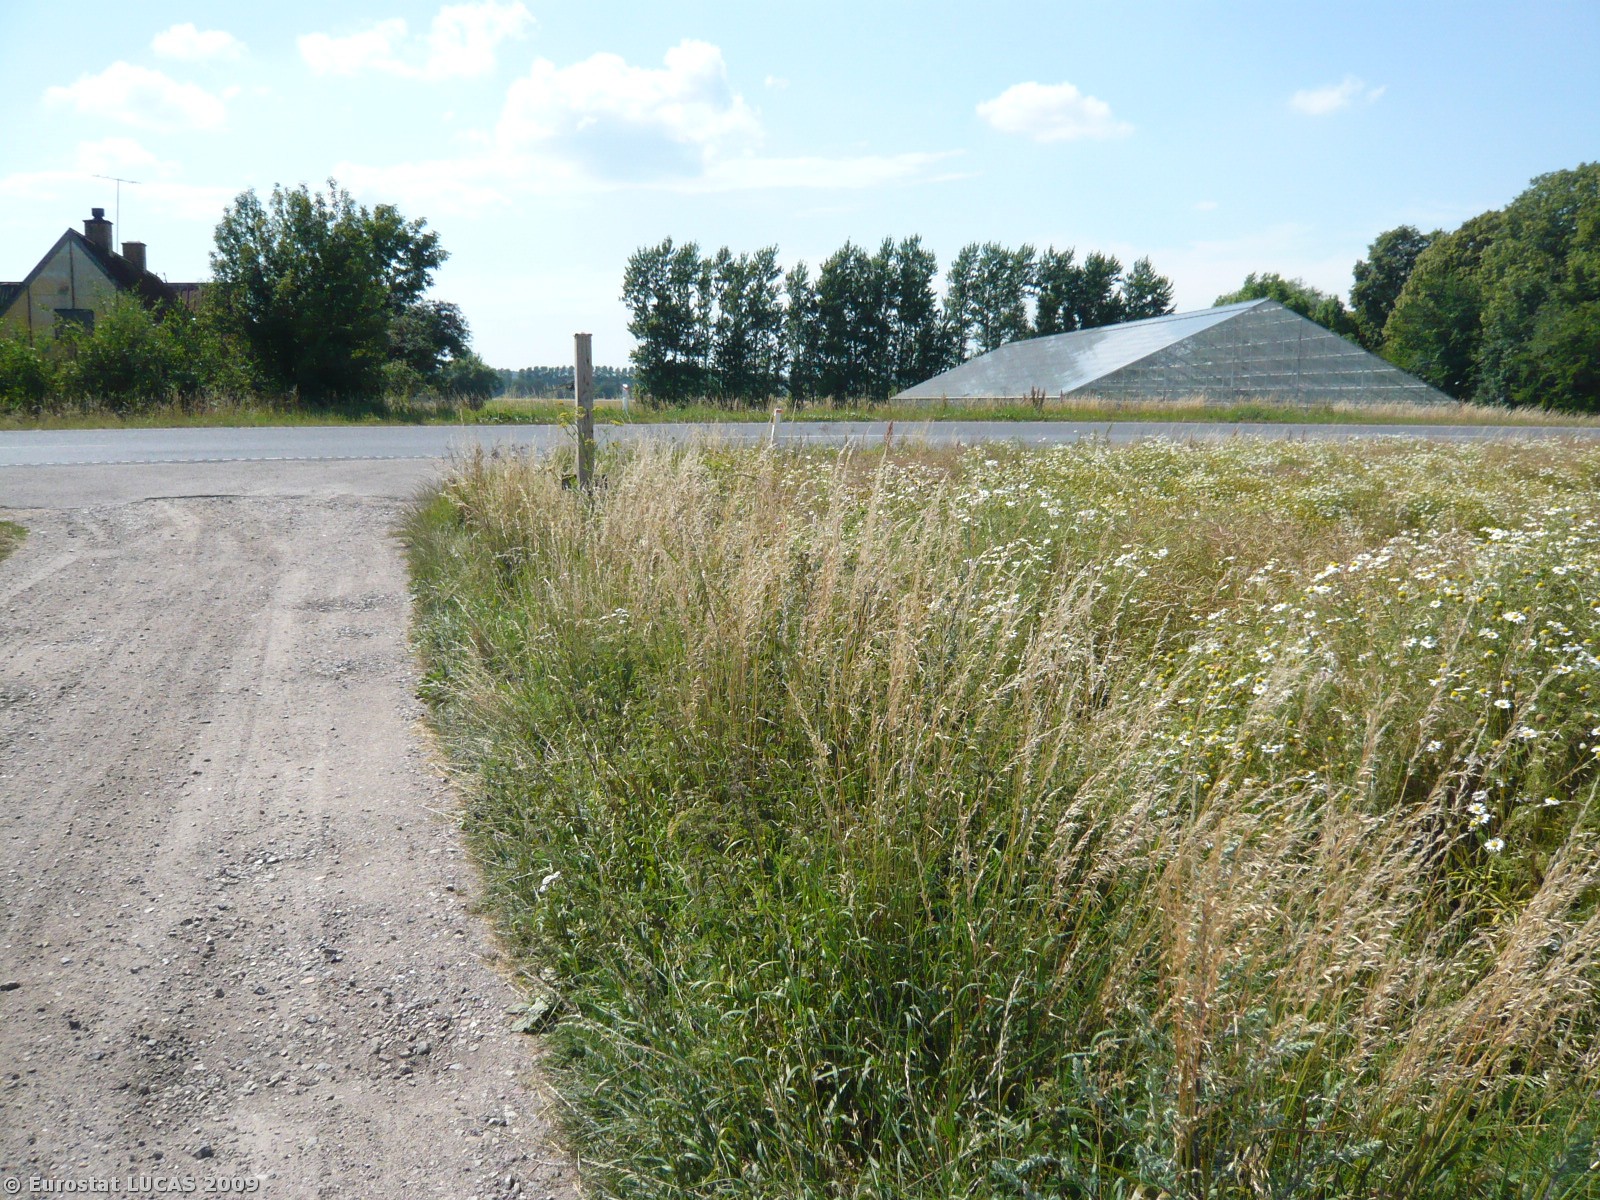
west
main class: Cropland
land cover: Rape and turnip rape
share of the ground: > 75 %
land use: Agriculture (excluding fallow land and kitchen gardens)
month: July
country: DK
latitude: 55.6938
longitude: 11.4781
